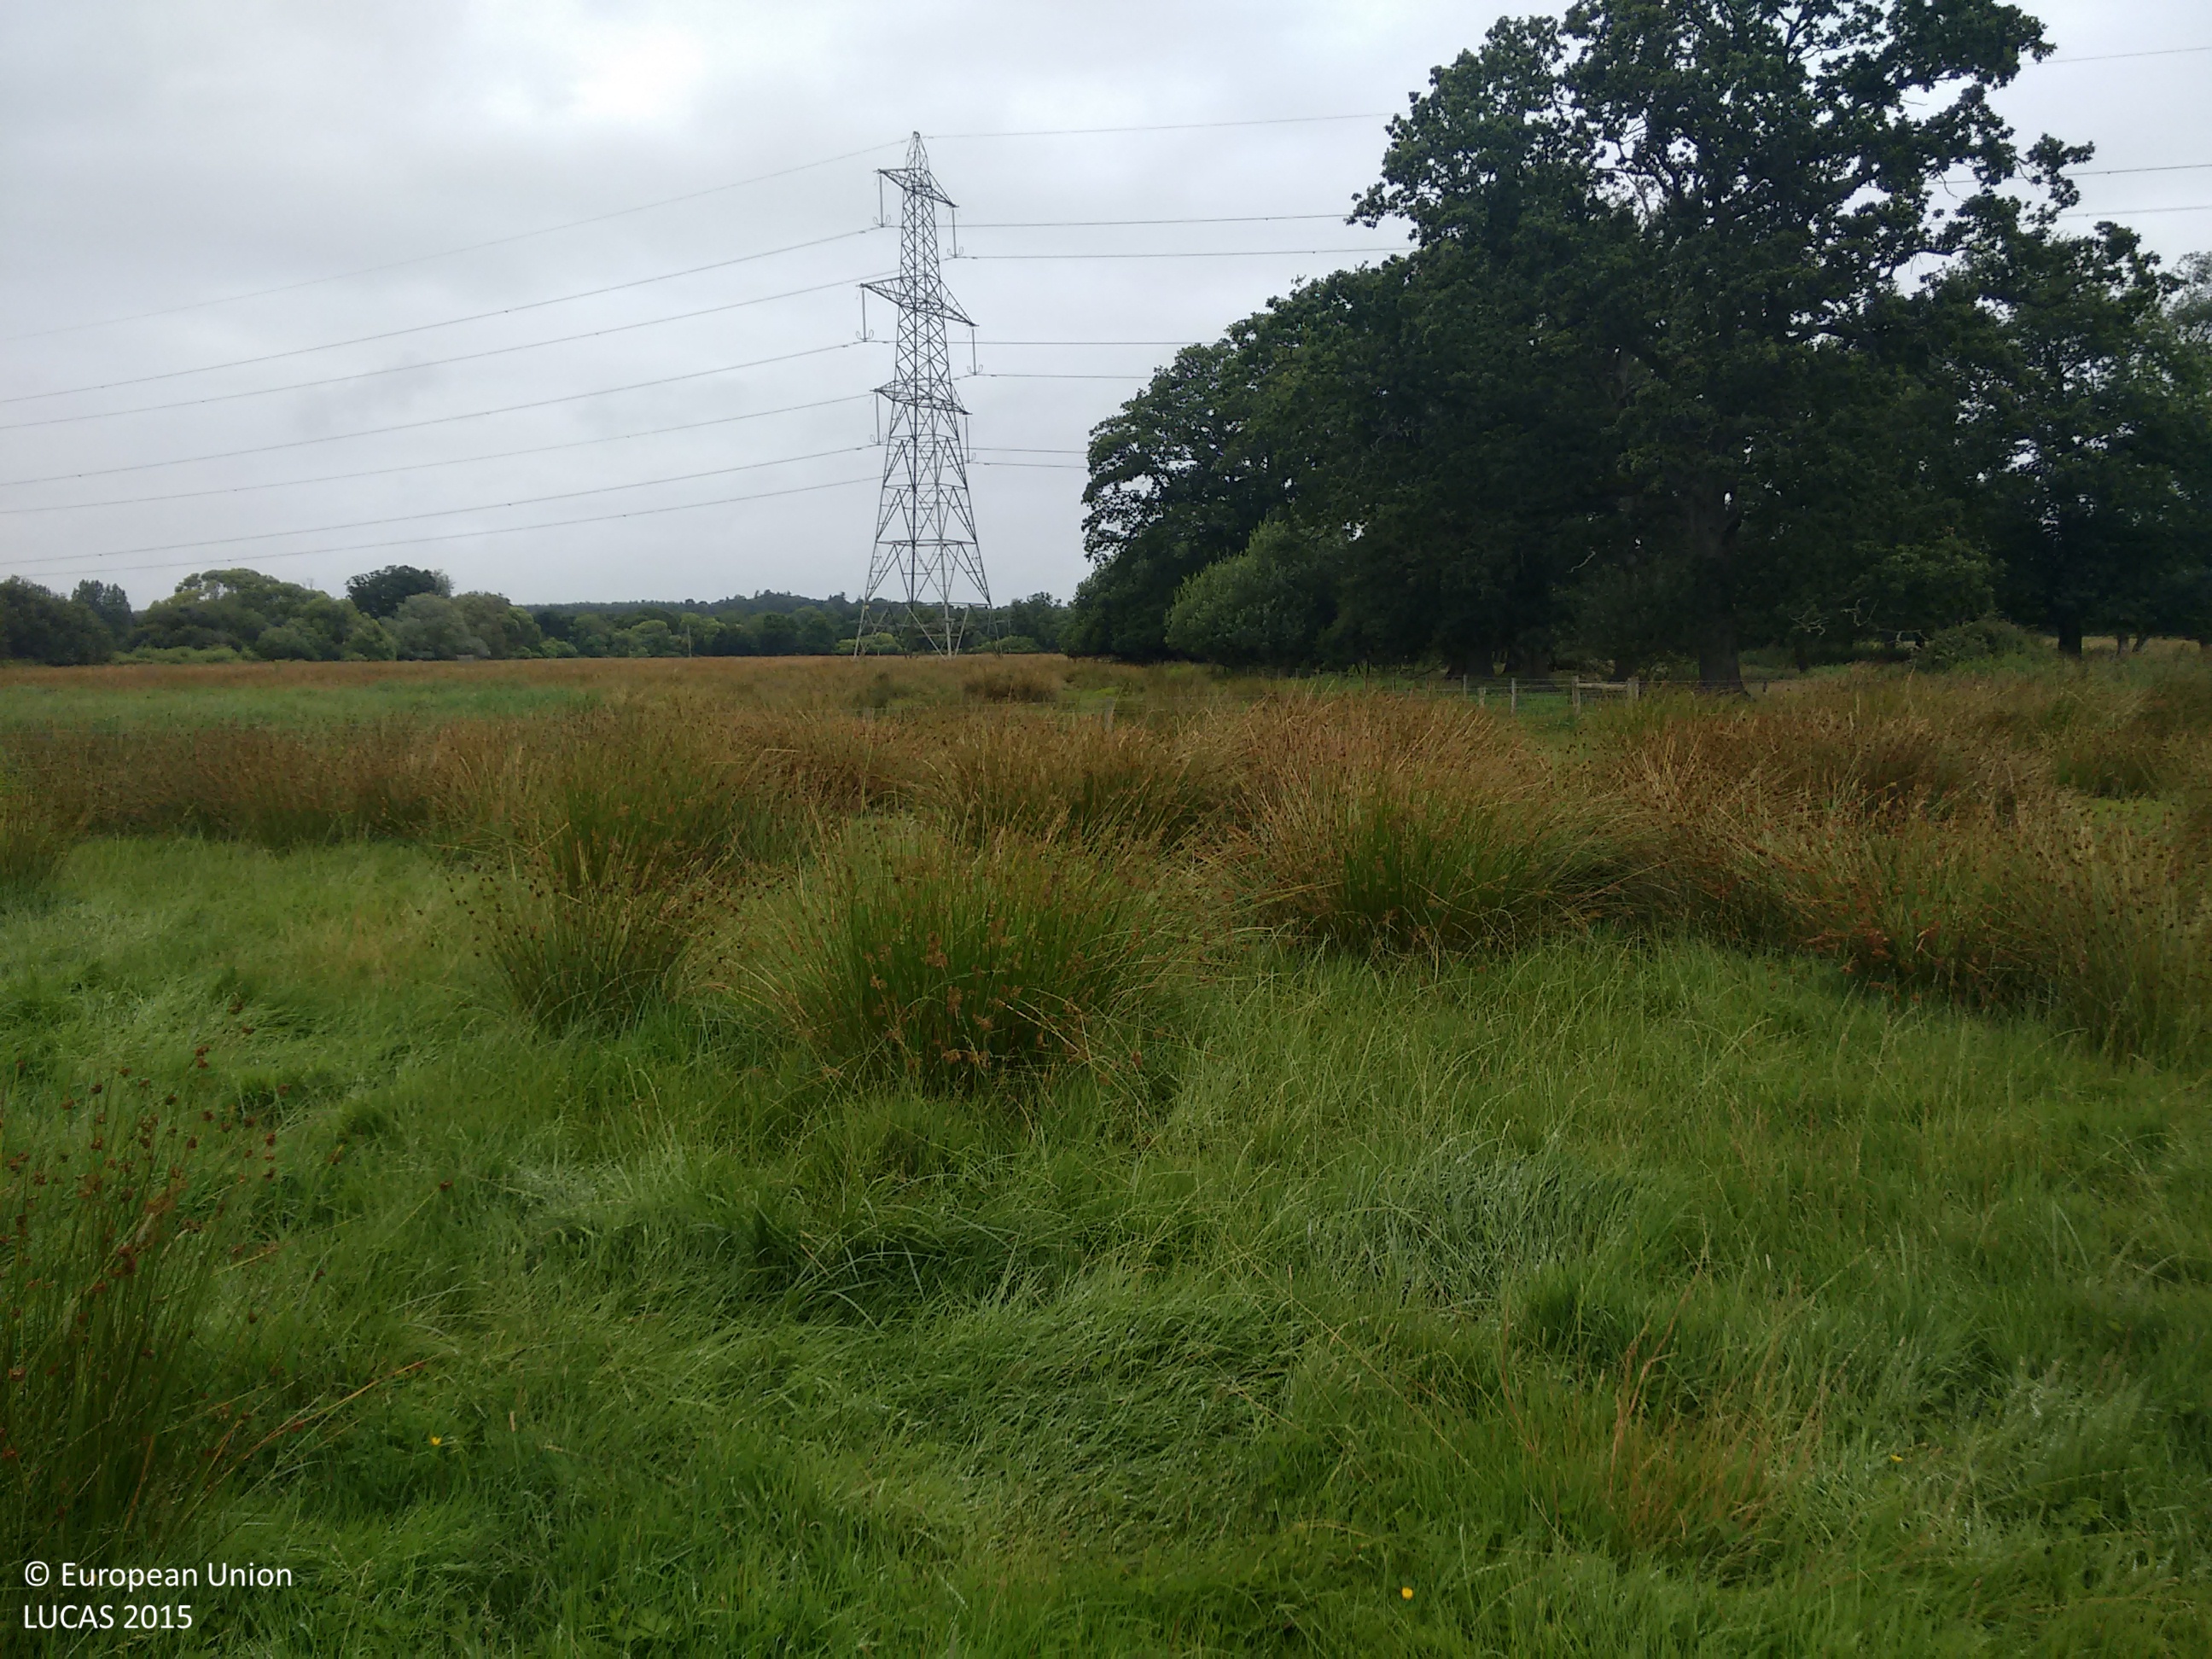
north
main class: Grassland
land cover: Grassland without tree/shrub cover
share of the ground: > 75 %
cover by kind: herbaceous plants 100 %
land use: Agriculture (excluding fallow land and kitchen gardens)
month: July
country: GB
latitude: 50.7681
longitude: -3.4539
